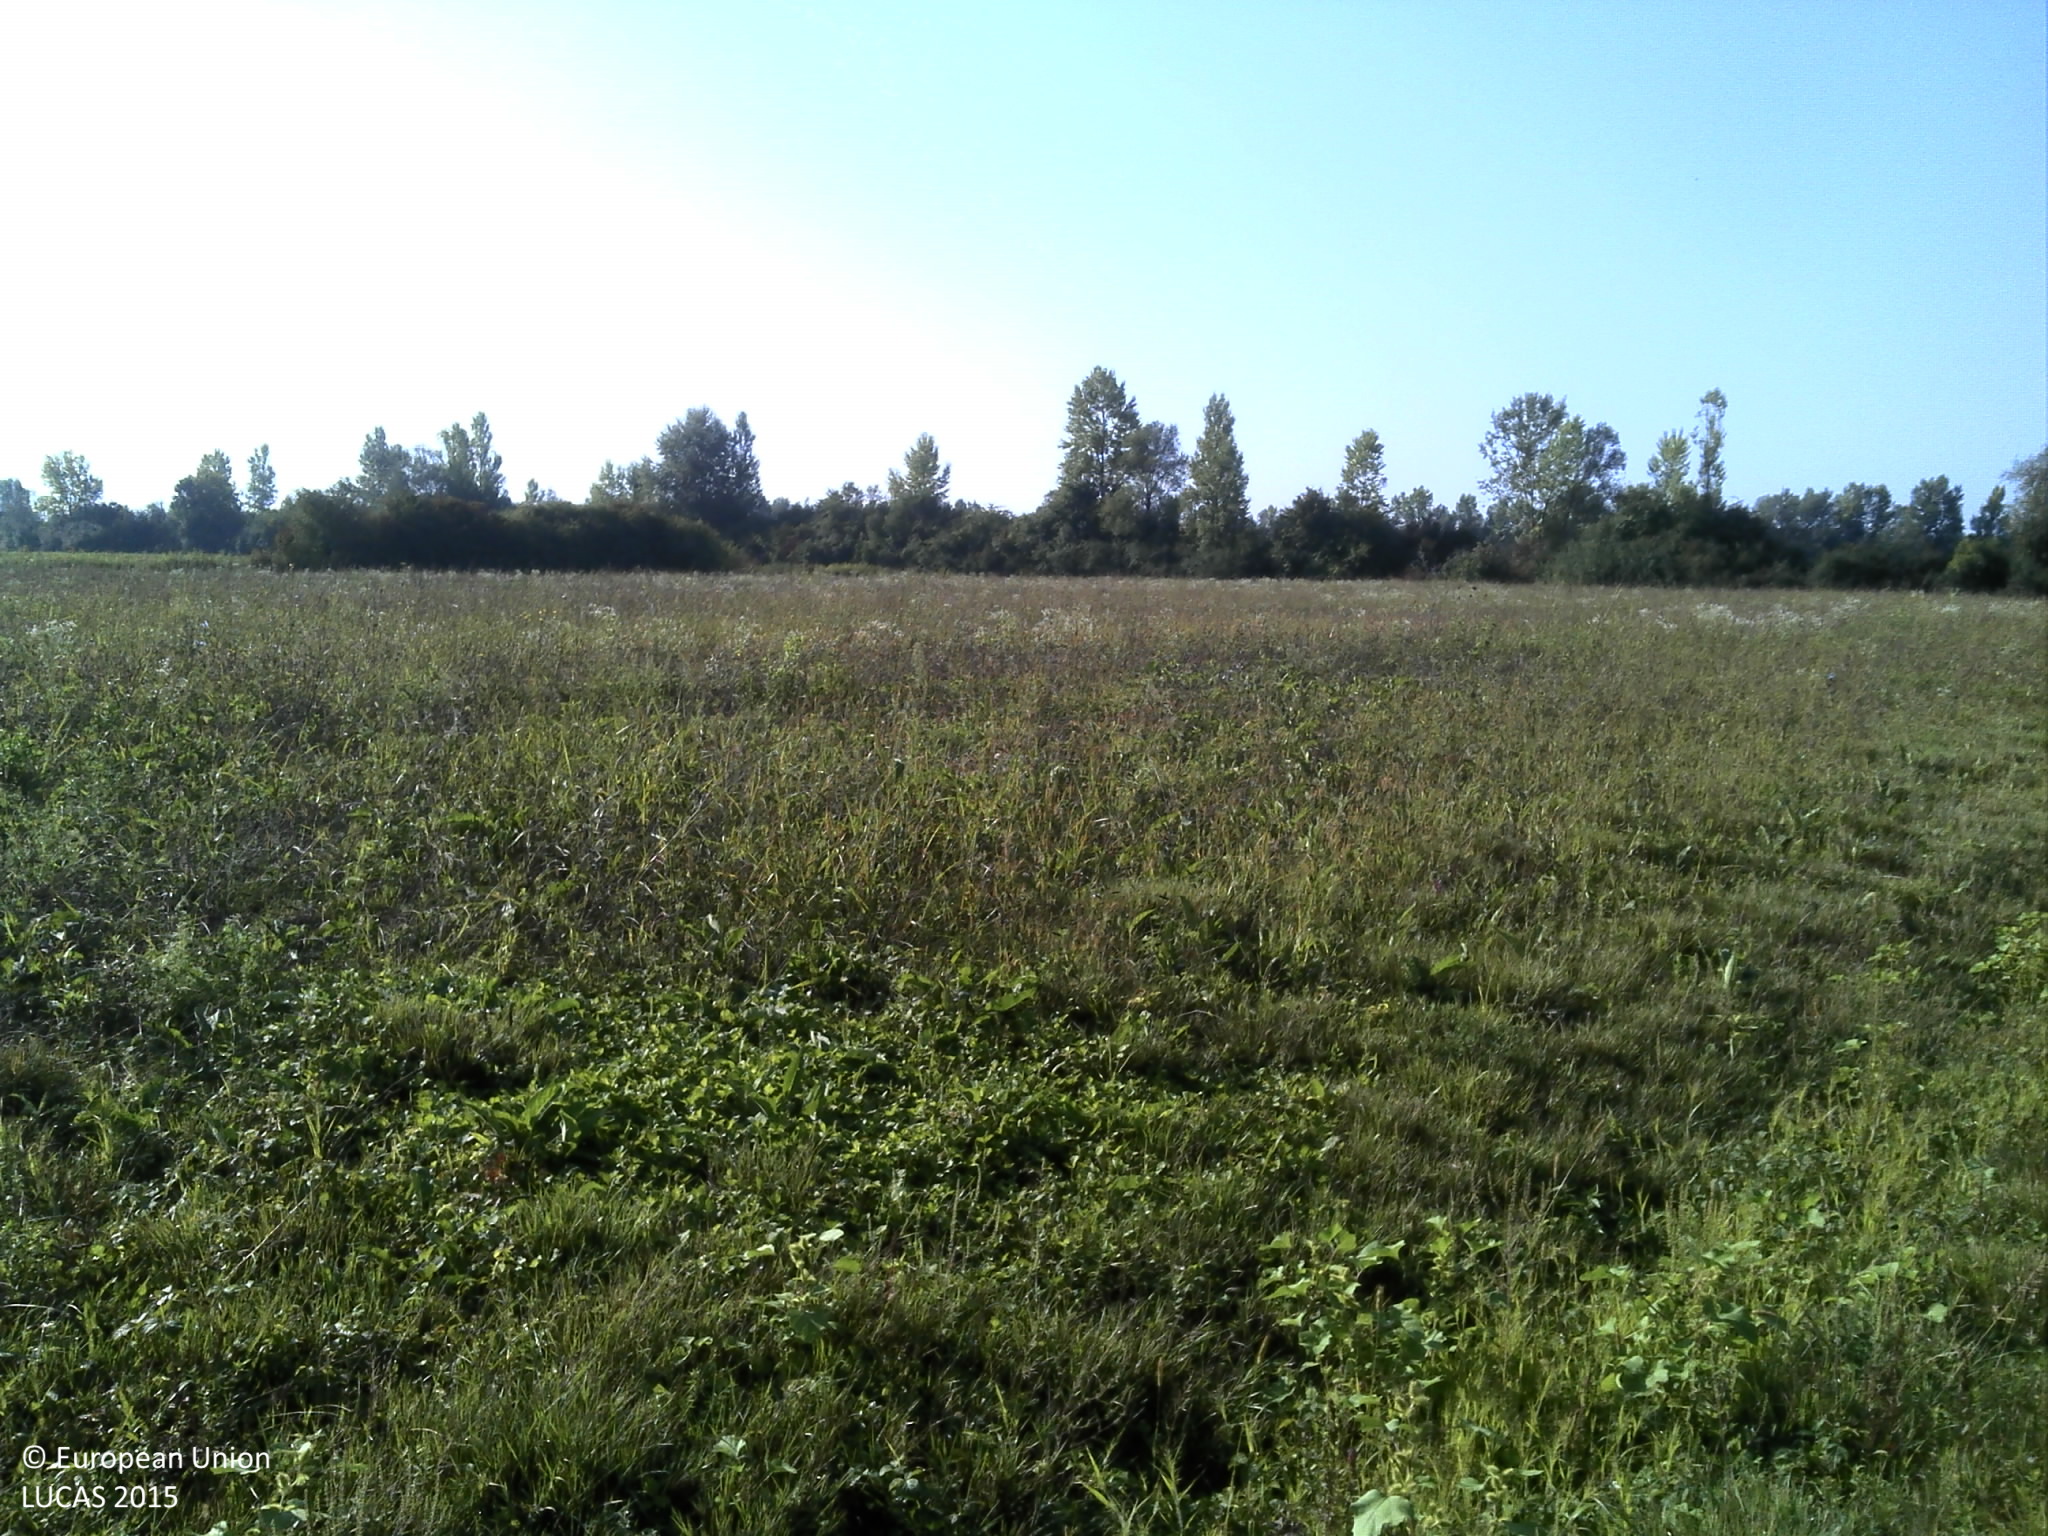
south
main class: Grassland
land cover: Grassland without tree/shrub cover
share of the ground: > 75 %
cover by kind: herbaceous plants 100 %
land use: Agriculture (excluding fallow land and kitchen gardens)
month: September
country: HR
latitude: 45.5817
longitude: 16.3935
